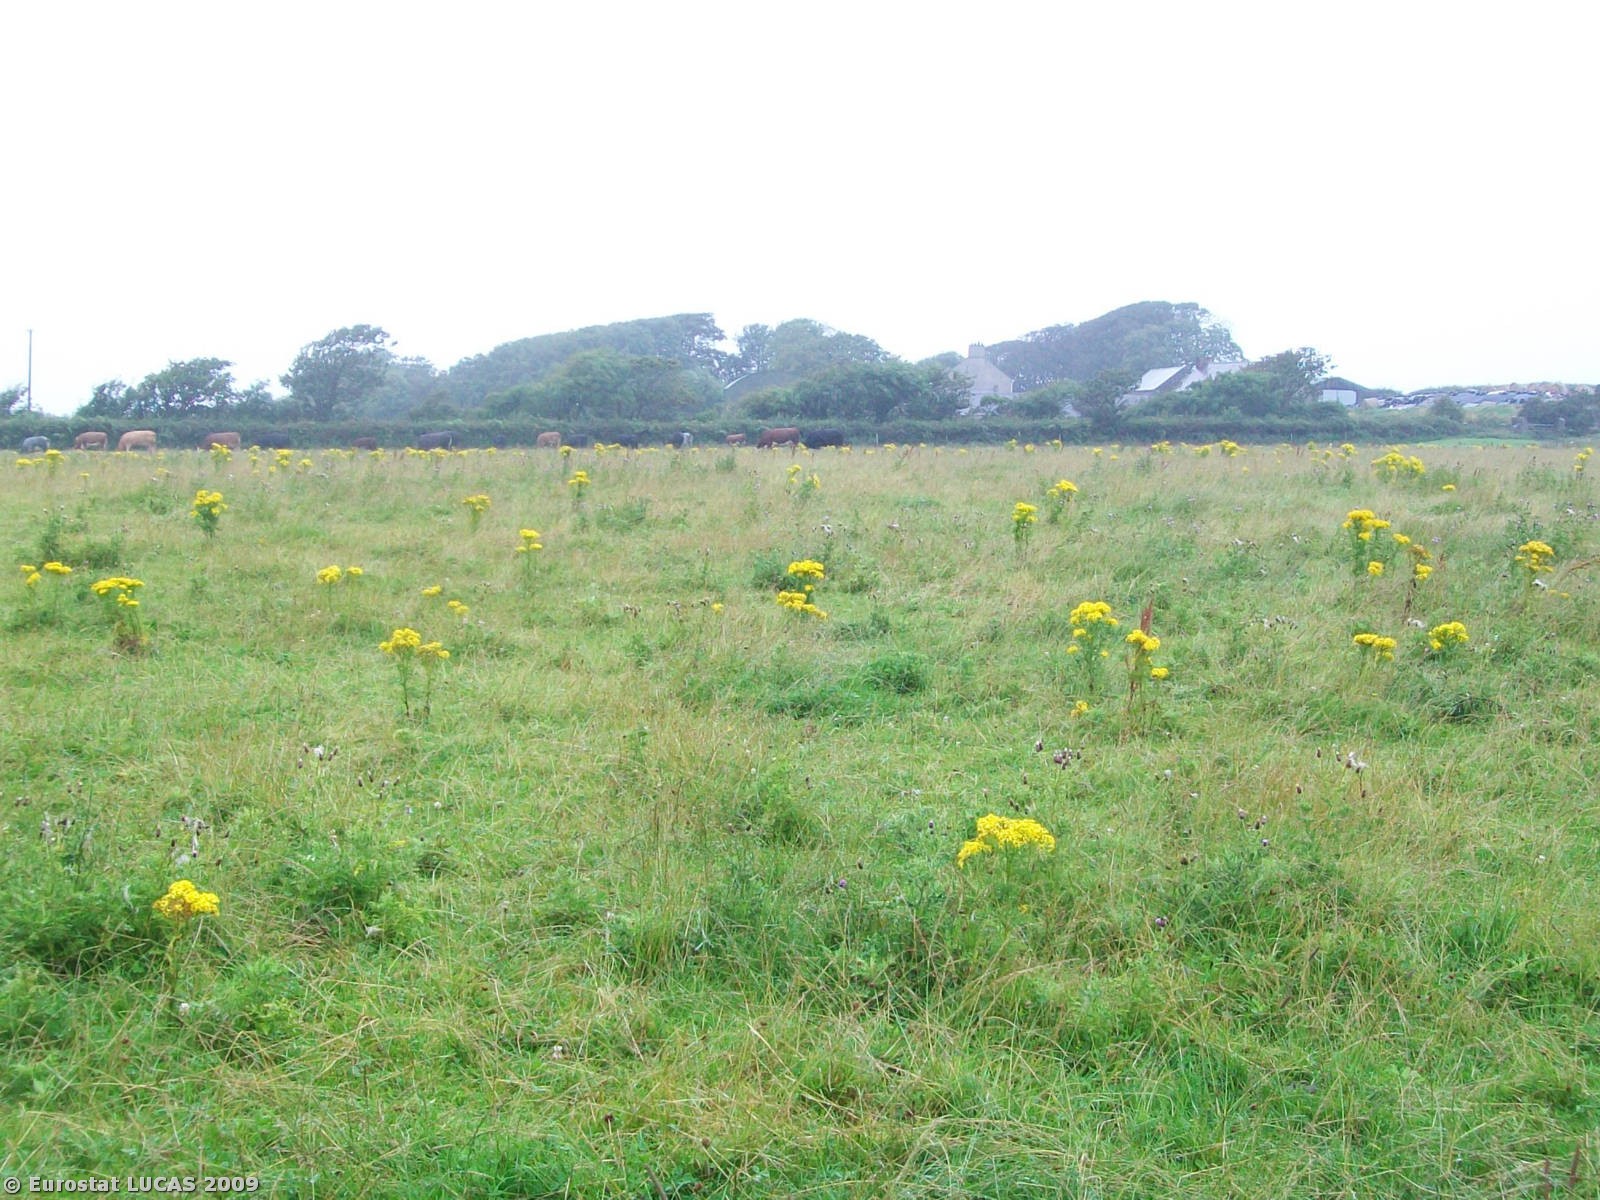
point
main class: Grassland
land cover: Grassland without tree/shrub cover
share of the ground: > 75 %
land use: Agriculture (excluding fallow land and kitchen gardens)
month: August
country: GB
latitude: 54.2716
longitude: -5.5936
